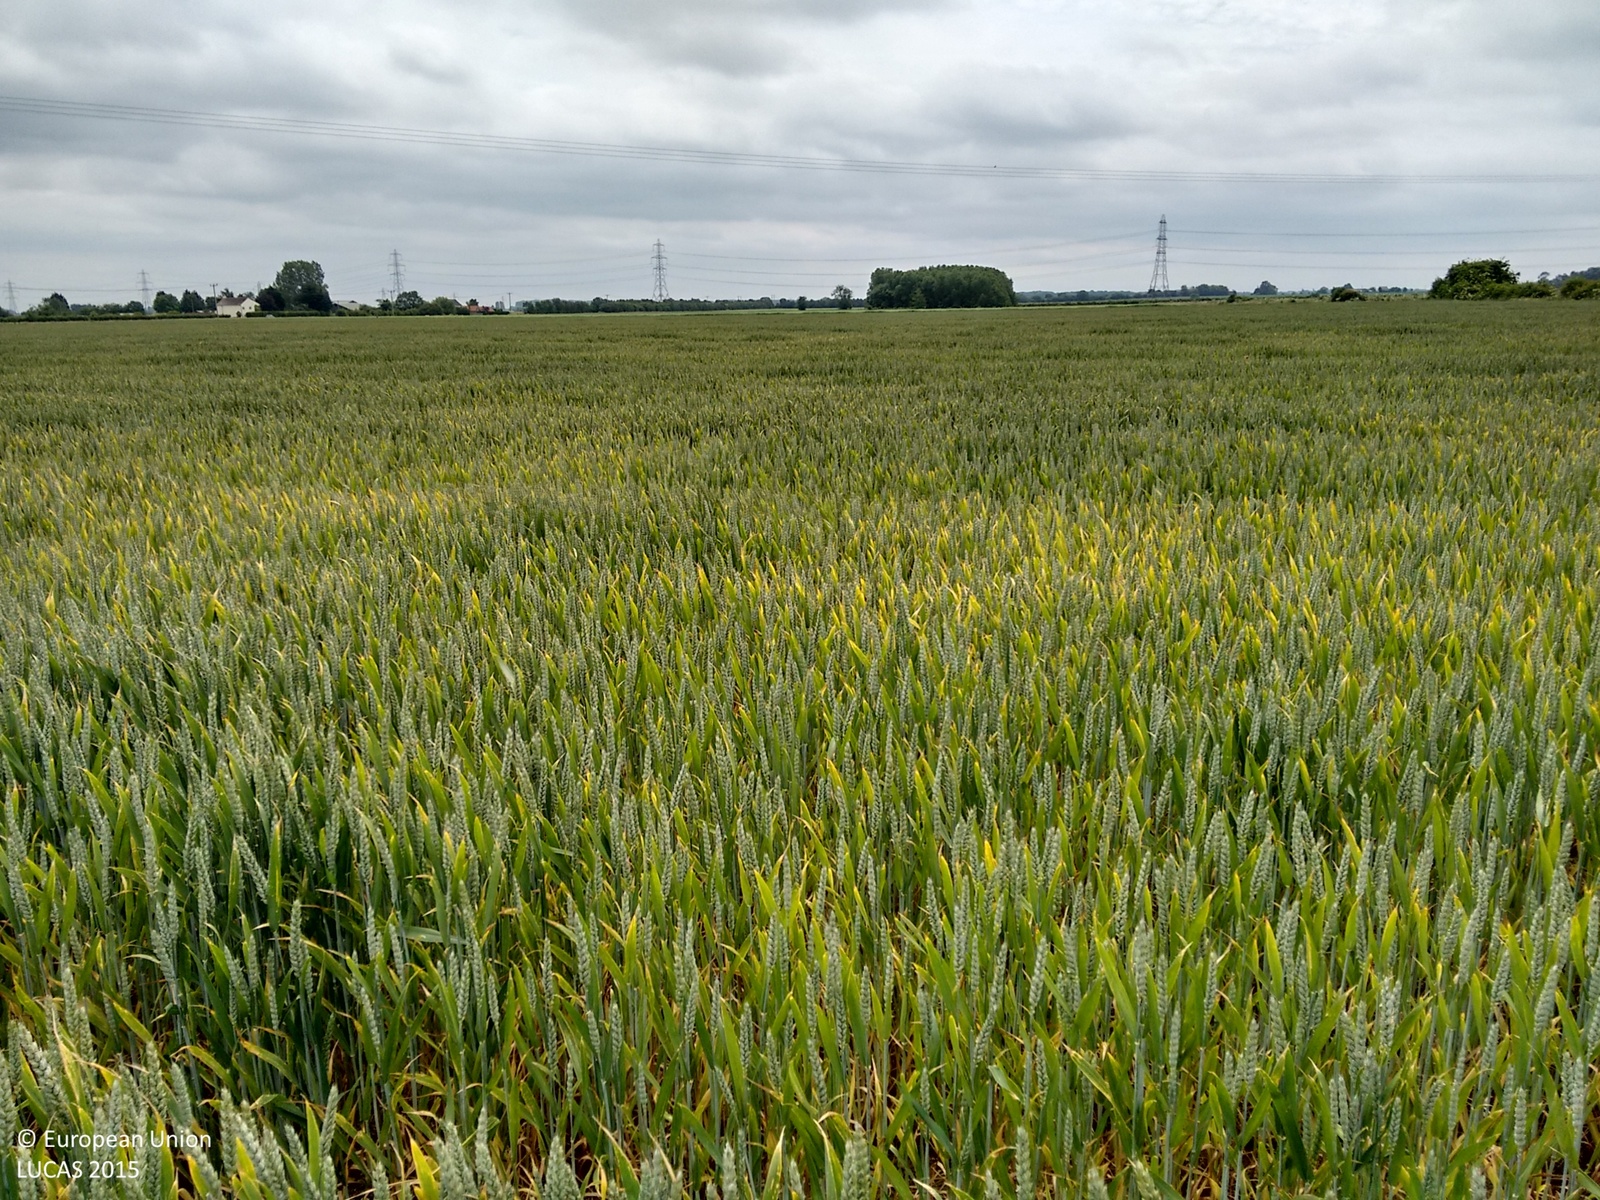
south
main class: Cropland
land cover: Common wheat
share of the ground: > 75 %
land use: Agriculture (excluding fallow land and kitchen gardens)
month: June
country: GB
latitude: 53.0433
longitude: -0.4029
